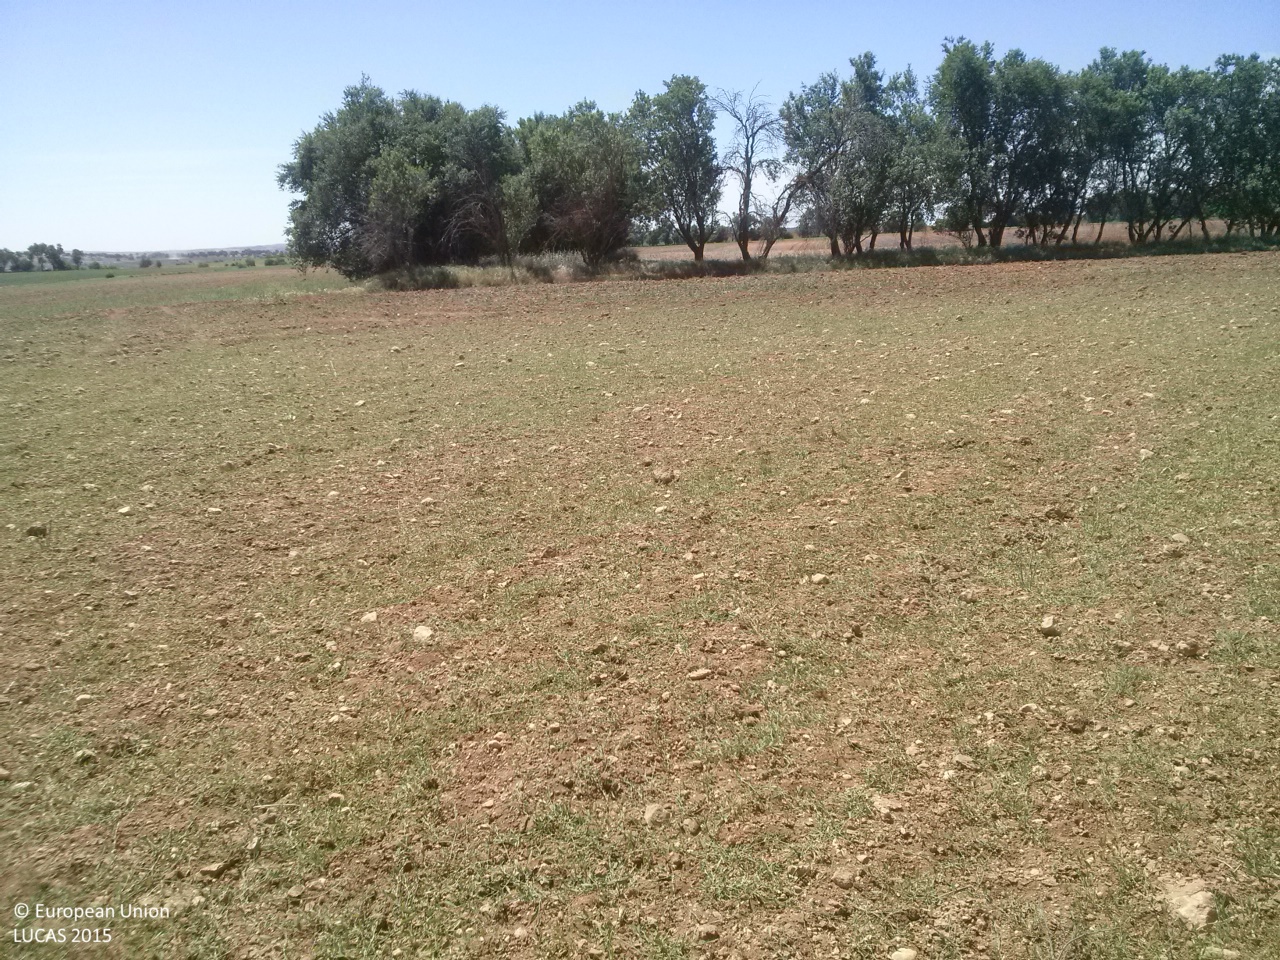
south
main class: Grassland
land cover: Spontaneously vegetated surfaces
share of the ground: 25 - 50 %
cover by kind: unconsolidated bare surface 60 %, herbaceous plants 40 %
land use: Fallow land
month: May
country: ES
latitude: 39.9389
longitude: -2.7883
